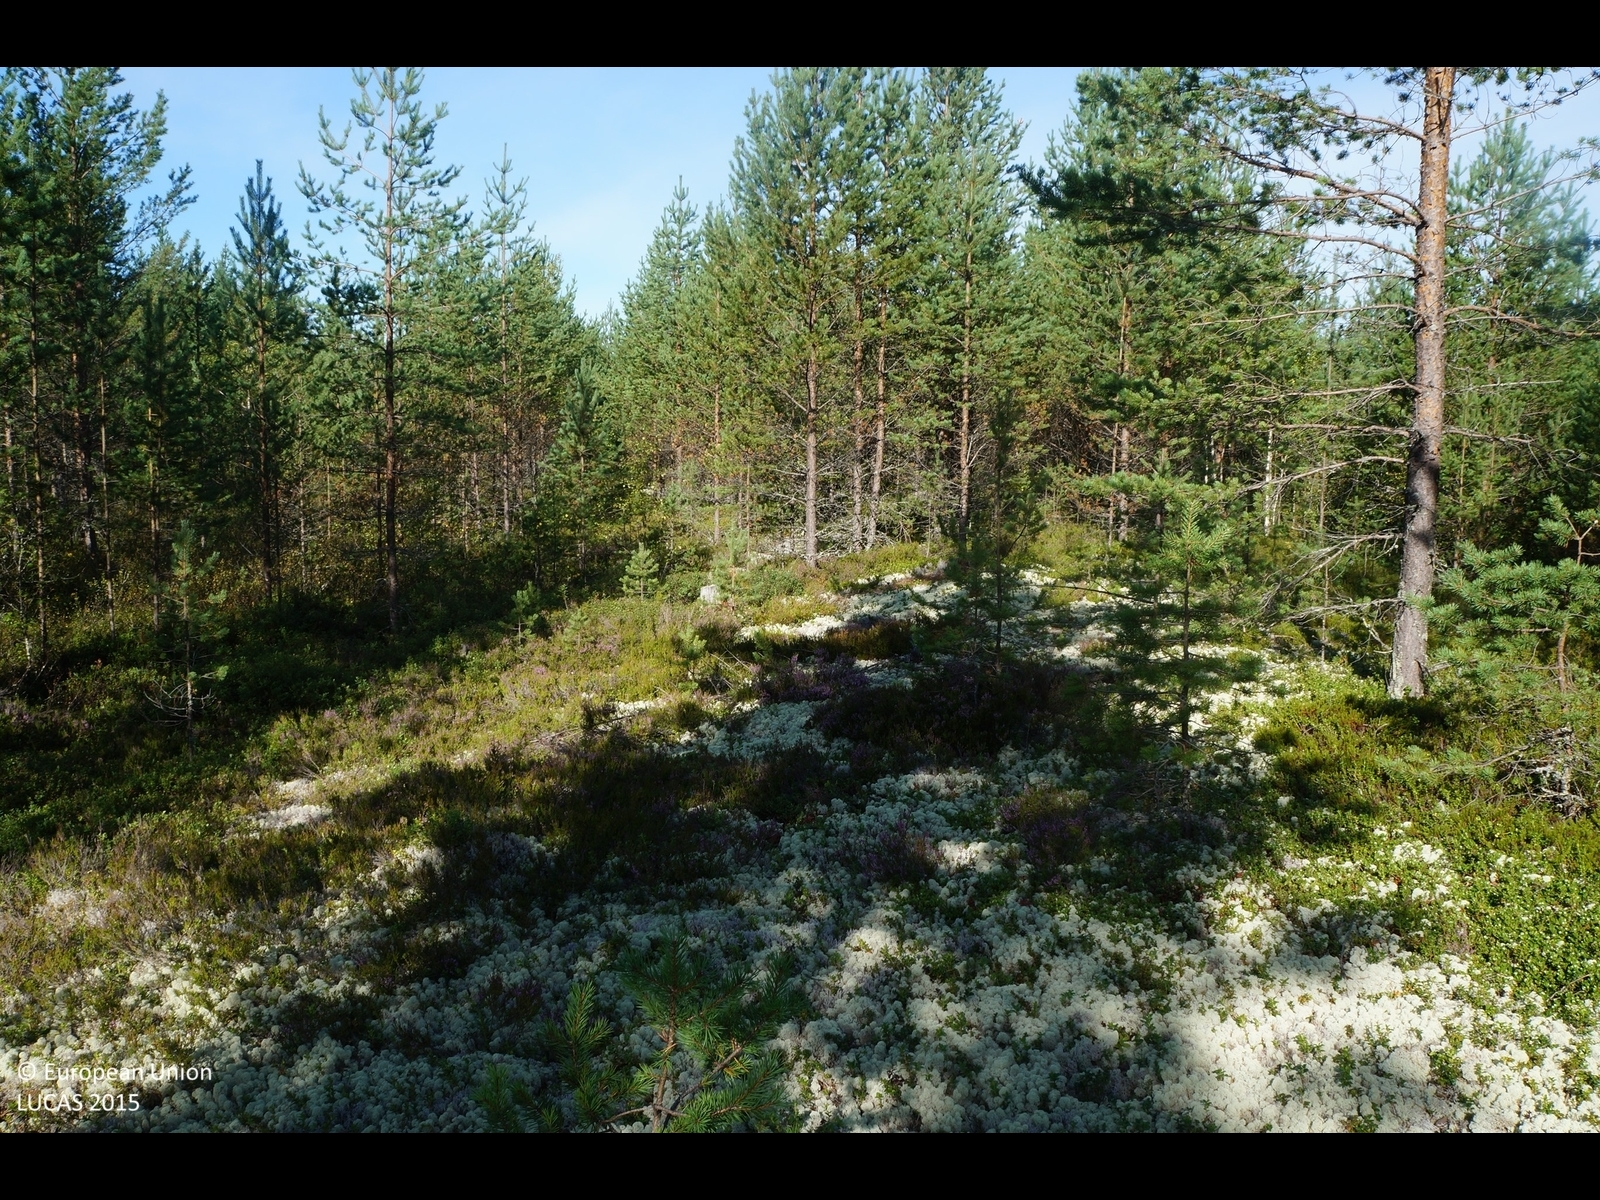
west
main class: Woodland
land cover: Pine dominated coniferous woodland
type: boreal forest
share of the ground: 25 - 50 %
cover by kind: coniferous forest trees 40 %, shrubs 30 %, lichens and mosses 30 %
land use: Forestry
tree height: > 5 m
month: August
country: FI
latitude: 64.8483
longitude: 24.9402
